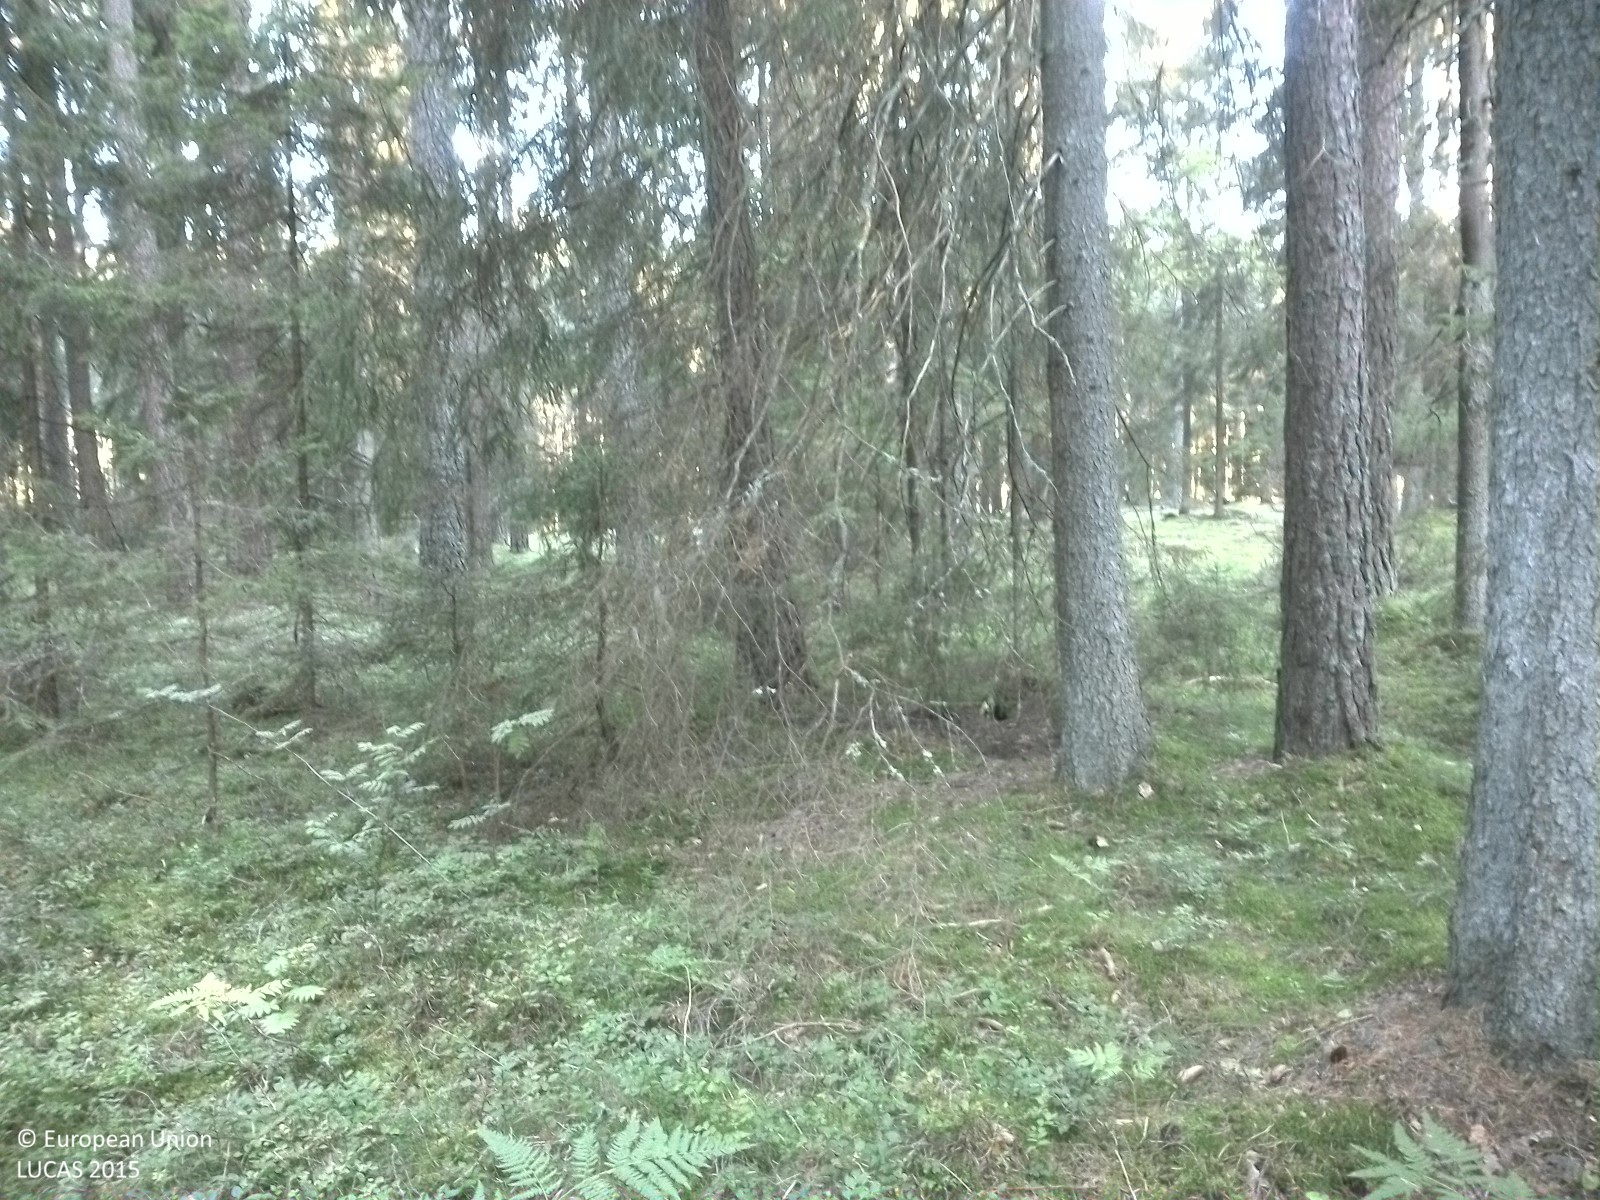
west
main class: Woodland
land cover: Other coniferous woodland
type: boreal forest
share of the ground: 25 - 50 %
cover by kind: coniferous forest trees 40 %, herbaceous plants 35 %, lichens and mosses 25 %
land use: Forestry
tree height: > 5 m
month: August
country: SE
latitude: 59.3306
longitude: 15.1061
